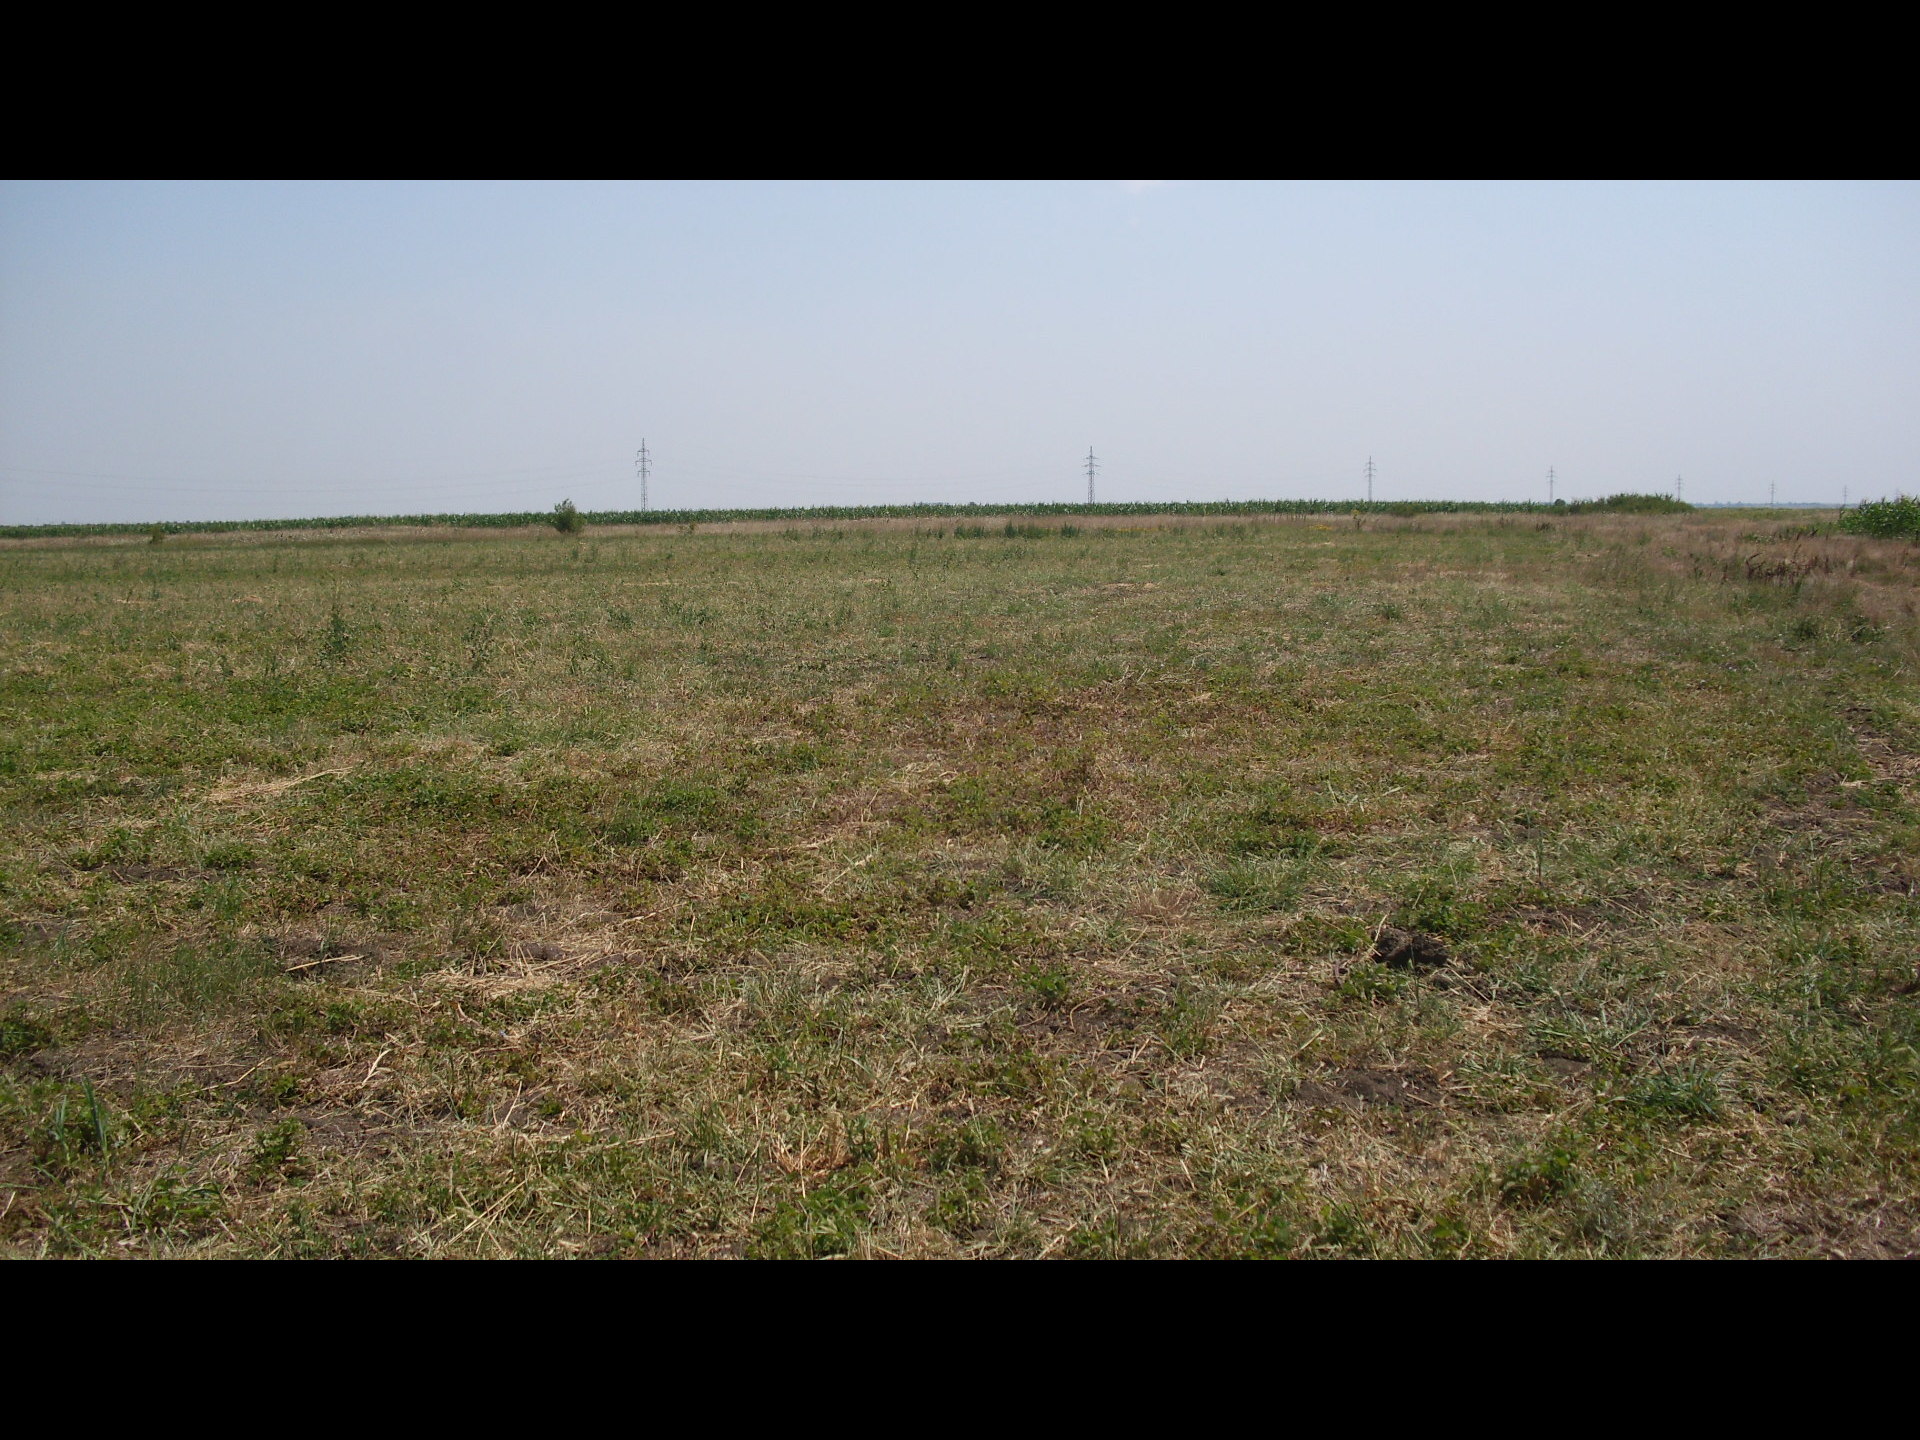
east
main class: Grassland
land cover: Spontaneously vegetated surfaces
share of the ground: > 75 %
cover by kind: herbaceous plants 100 %
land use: Agriculture (excluding fallow land and kitchen gardens)
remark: Harvested field
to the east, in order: Spontaneously vegetated surfaces; Ditches and canals; Grass margins; Tracks; Grassland without tree/shrub cover; Maize
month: July
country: BG
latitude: 43.5997
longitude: 23.1591
